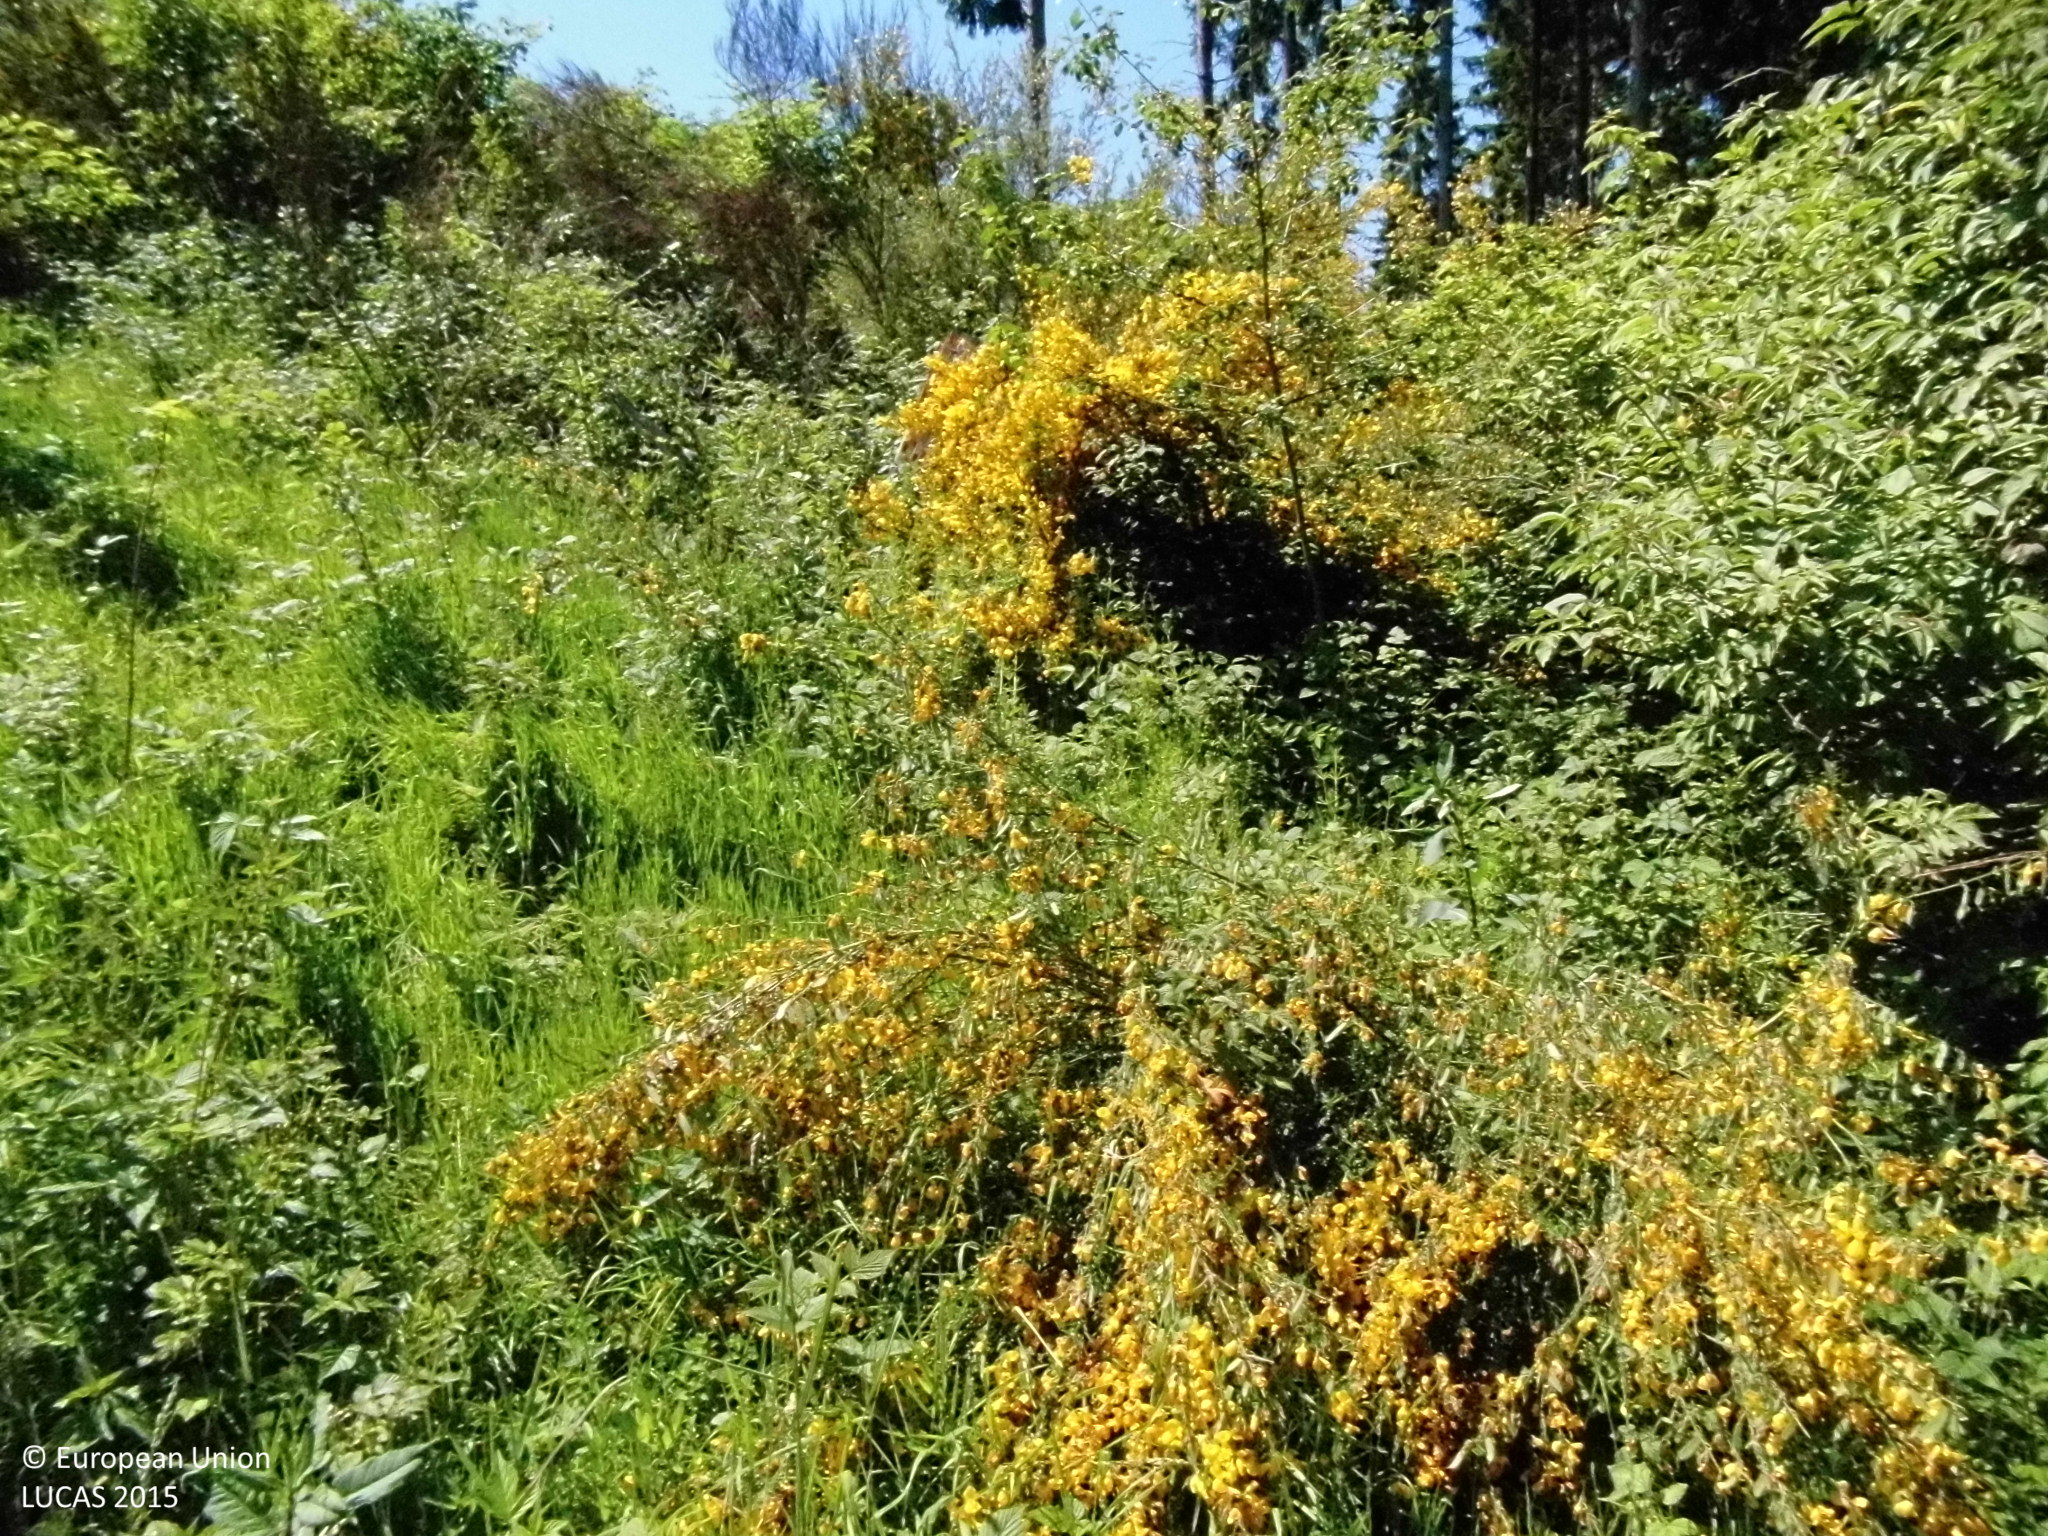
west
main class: Shrubland
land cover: Shrubland with sparse tree cover
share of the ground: > 75 %
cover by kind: shrubs 85 %, herbaceous plants 10 %, broadleaved forest trees 5 %
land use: Semi-natural and natural areas not in use
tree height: < 5 m
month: June
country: DE
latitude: 50.8516
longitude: 8.0828
